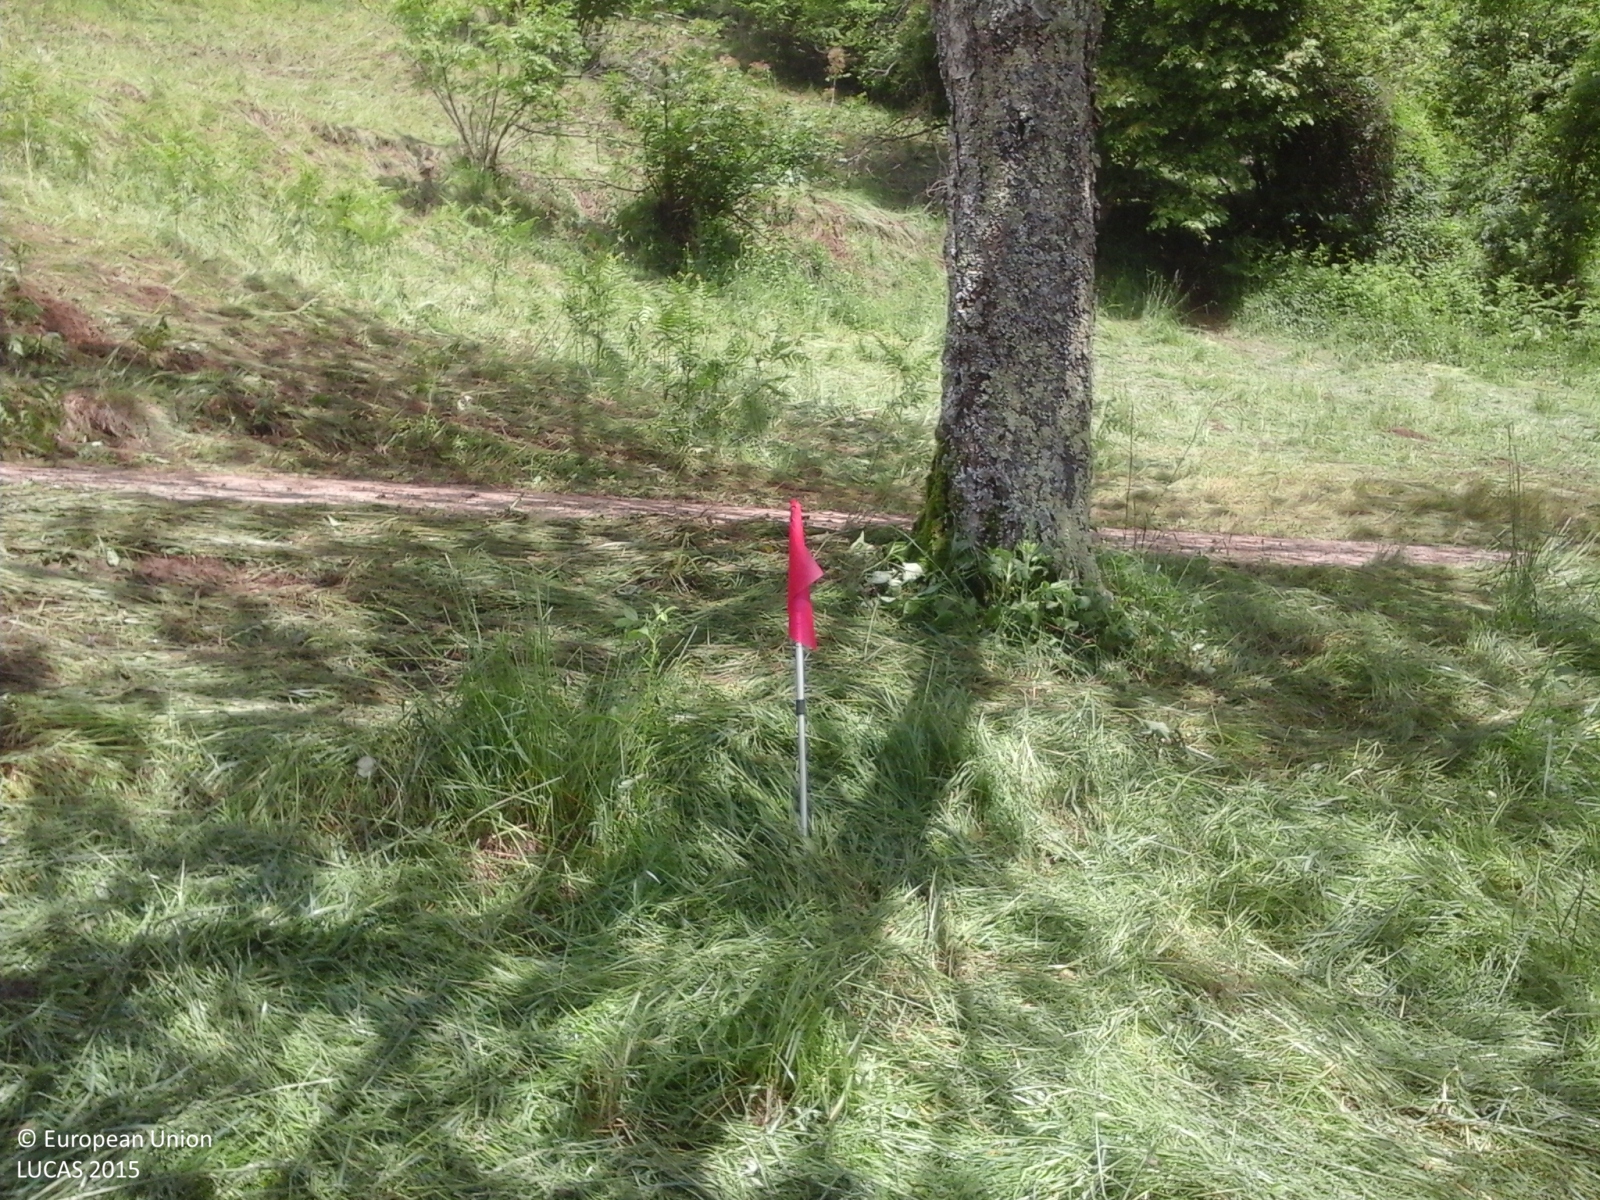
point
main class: Cropland
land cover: Cherry fruit
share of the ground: 25 - 50 %
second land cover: Grassland without tree/shrub cover
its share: > 75 %
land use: Agriculture (excluding fallow land and kitchen gardens)
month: May
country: IT
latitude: 45.7133
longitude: 11.2441
